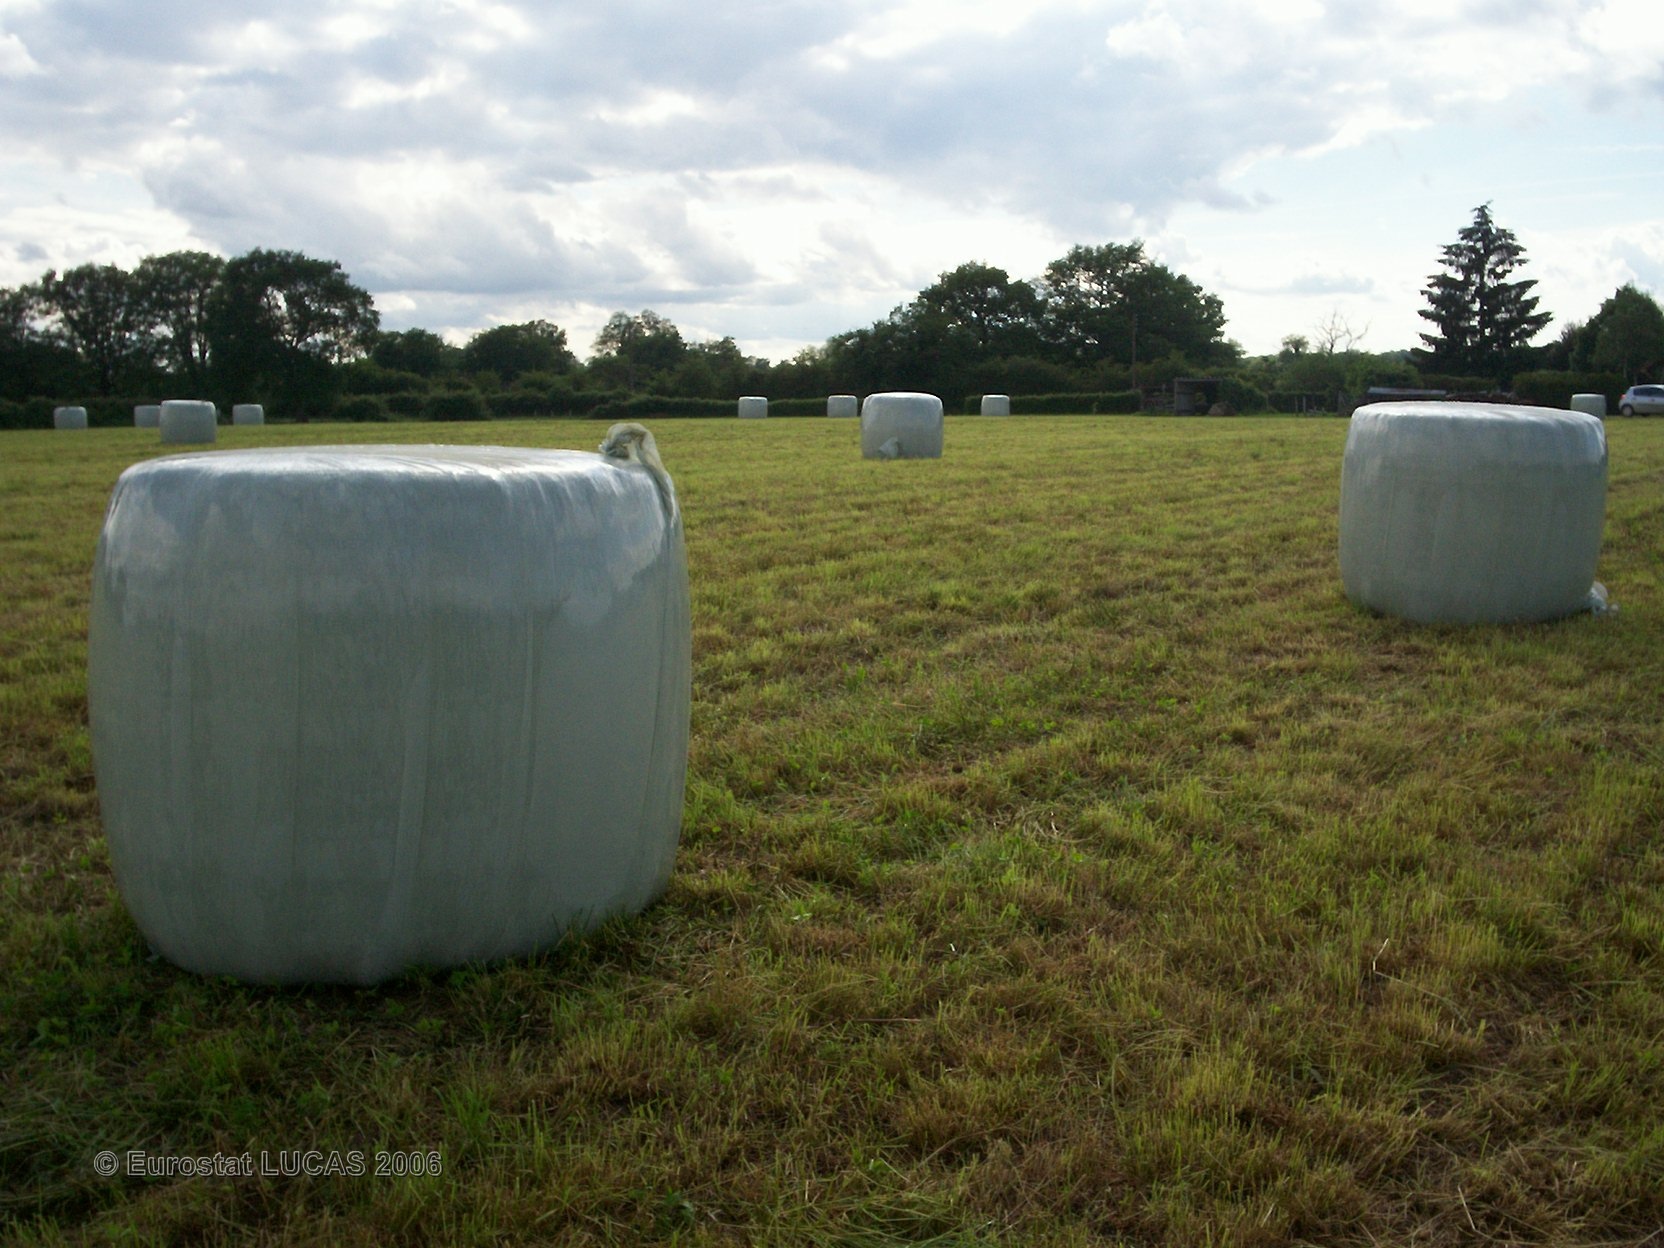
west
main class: Grassland
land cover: Grassland without tree/shrub cover
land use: Agriculture (excluding fallow land and kitchen gardens)
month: May
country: FR
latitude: 46.8289
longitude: 3.0352
